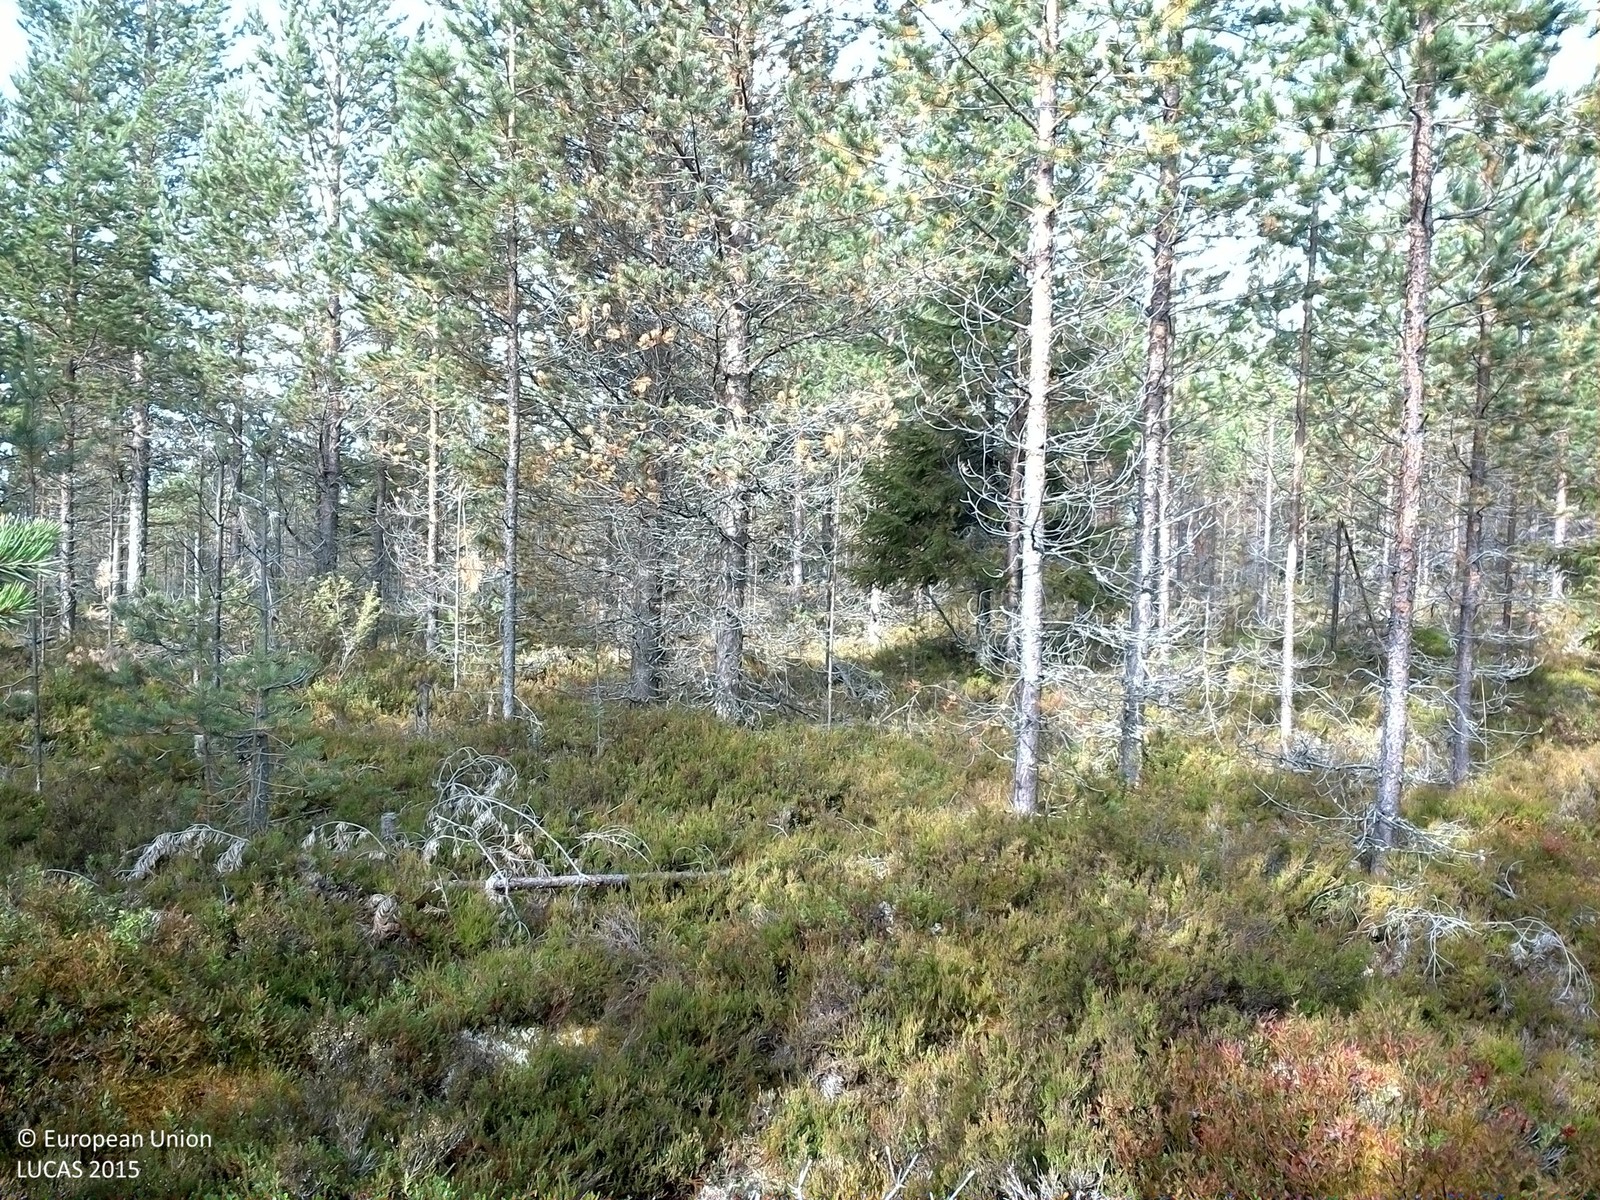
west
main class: Woodland
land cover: Pine dominated coniferous woodland
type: boreal forest
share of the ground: 25 - 50 %
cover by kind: shrubs 45 %, coniferous forest trees 35 %, lichens and mosses 15 %, broadleaved forest trees 5 %
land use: Forestry
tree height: > 5 m
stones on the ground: 10 - 25 %
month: September
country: SE
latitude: 63.9901
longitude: 16.5725
